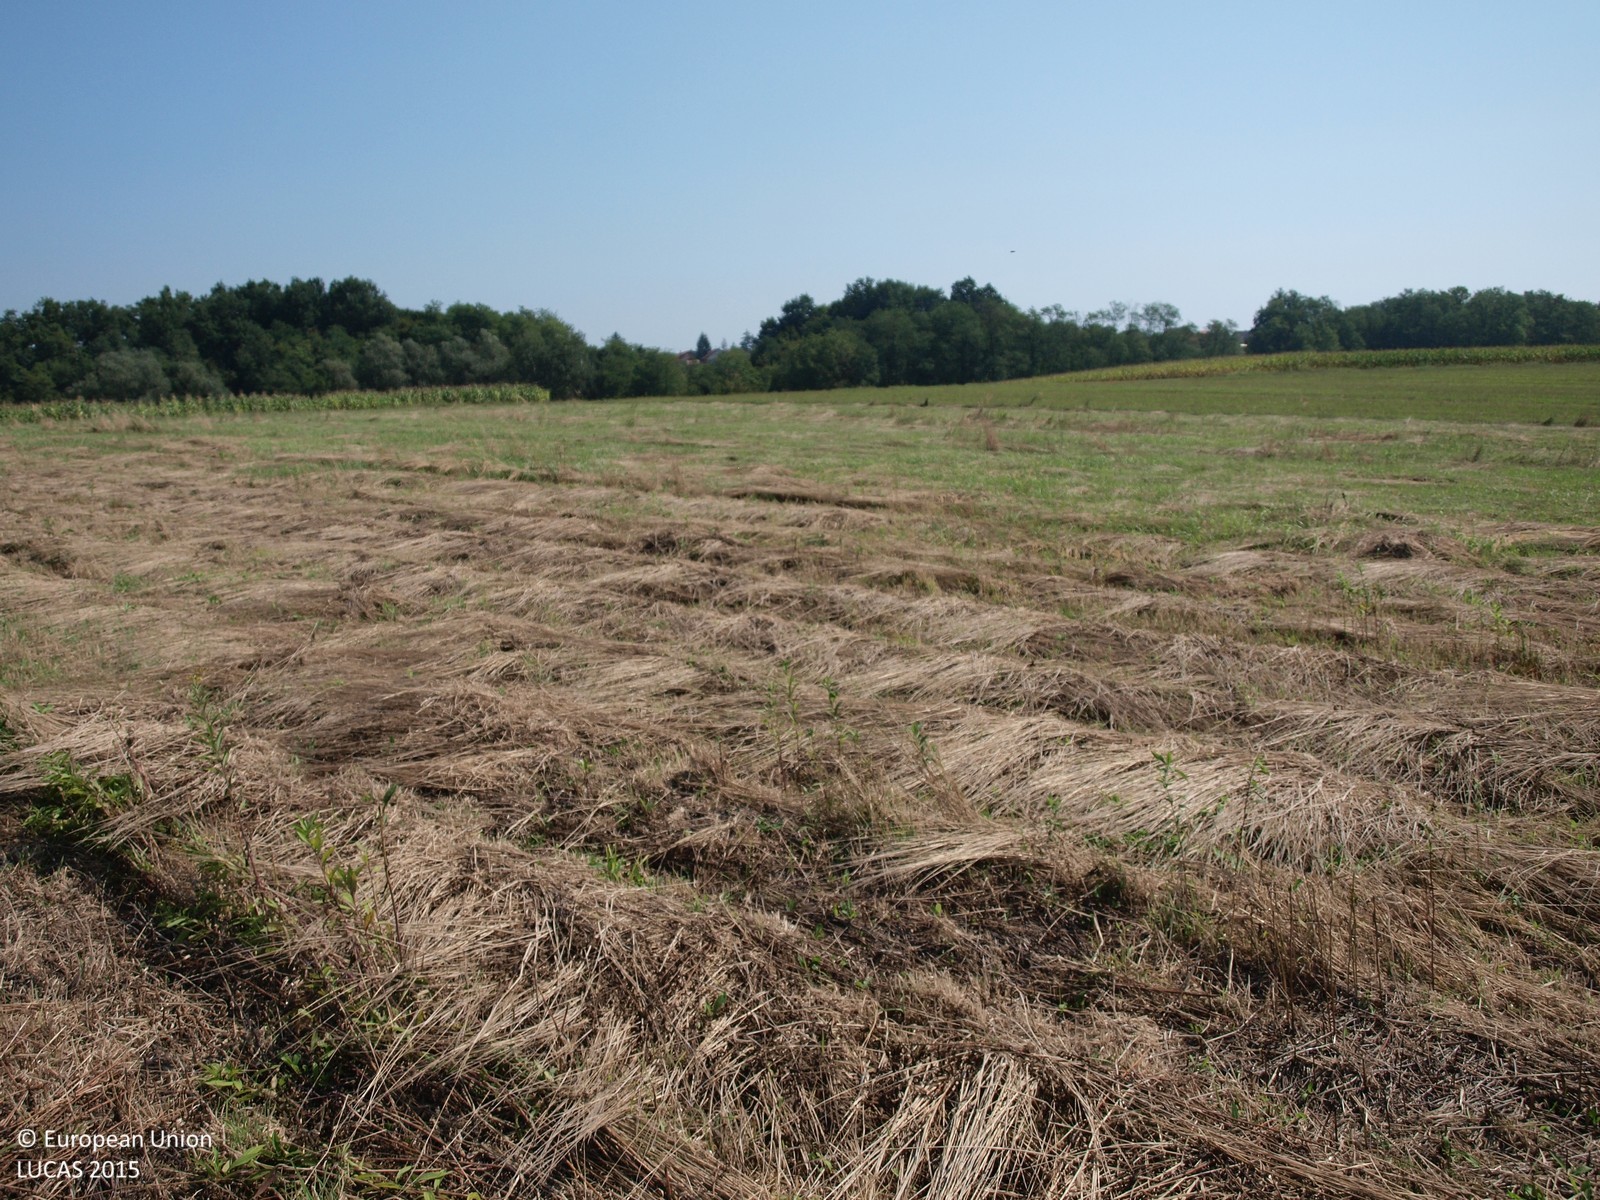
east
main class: Grassland
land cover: Grassland without tree/shrub cover
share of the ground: > 75 %
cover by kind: herbaceous plants 100 %
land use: Agriculture (excluding fallow land and kitchen gardens)
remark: Harvested field
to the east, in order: Grassland without tree/shrub cover; Barley; Tracks; Grassland without tree/shrub cover; Broadleaved woodland
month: August
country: HR
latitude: 45.6831
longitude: 16.5083
